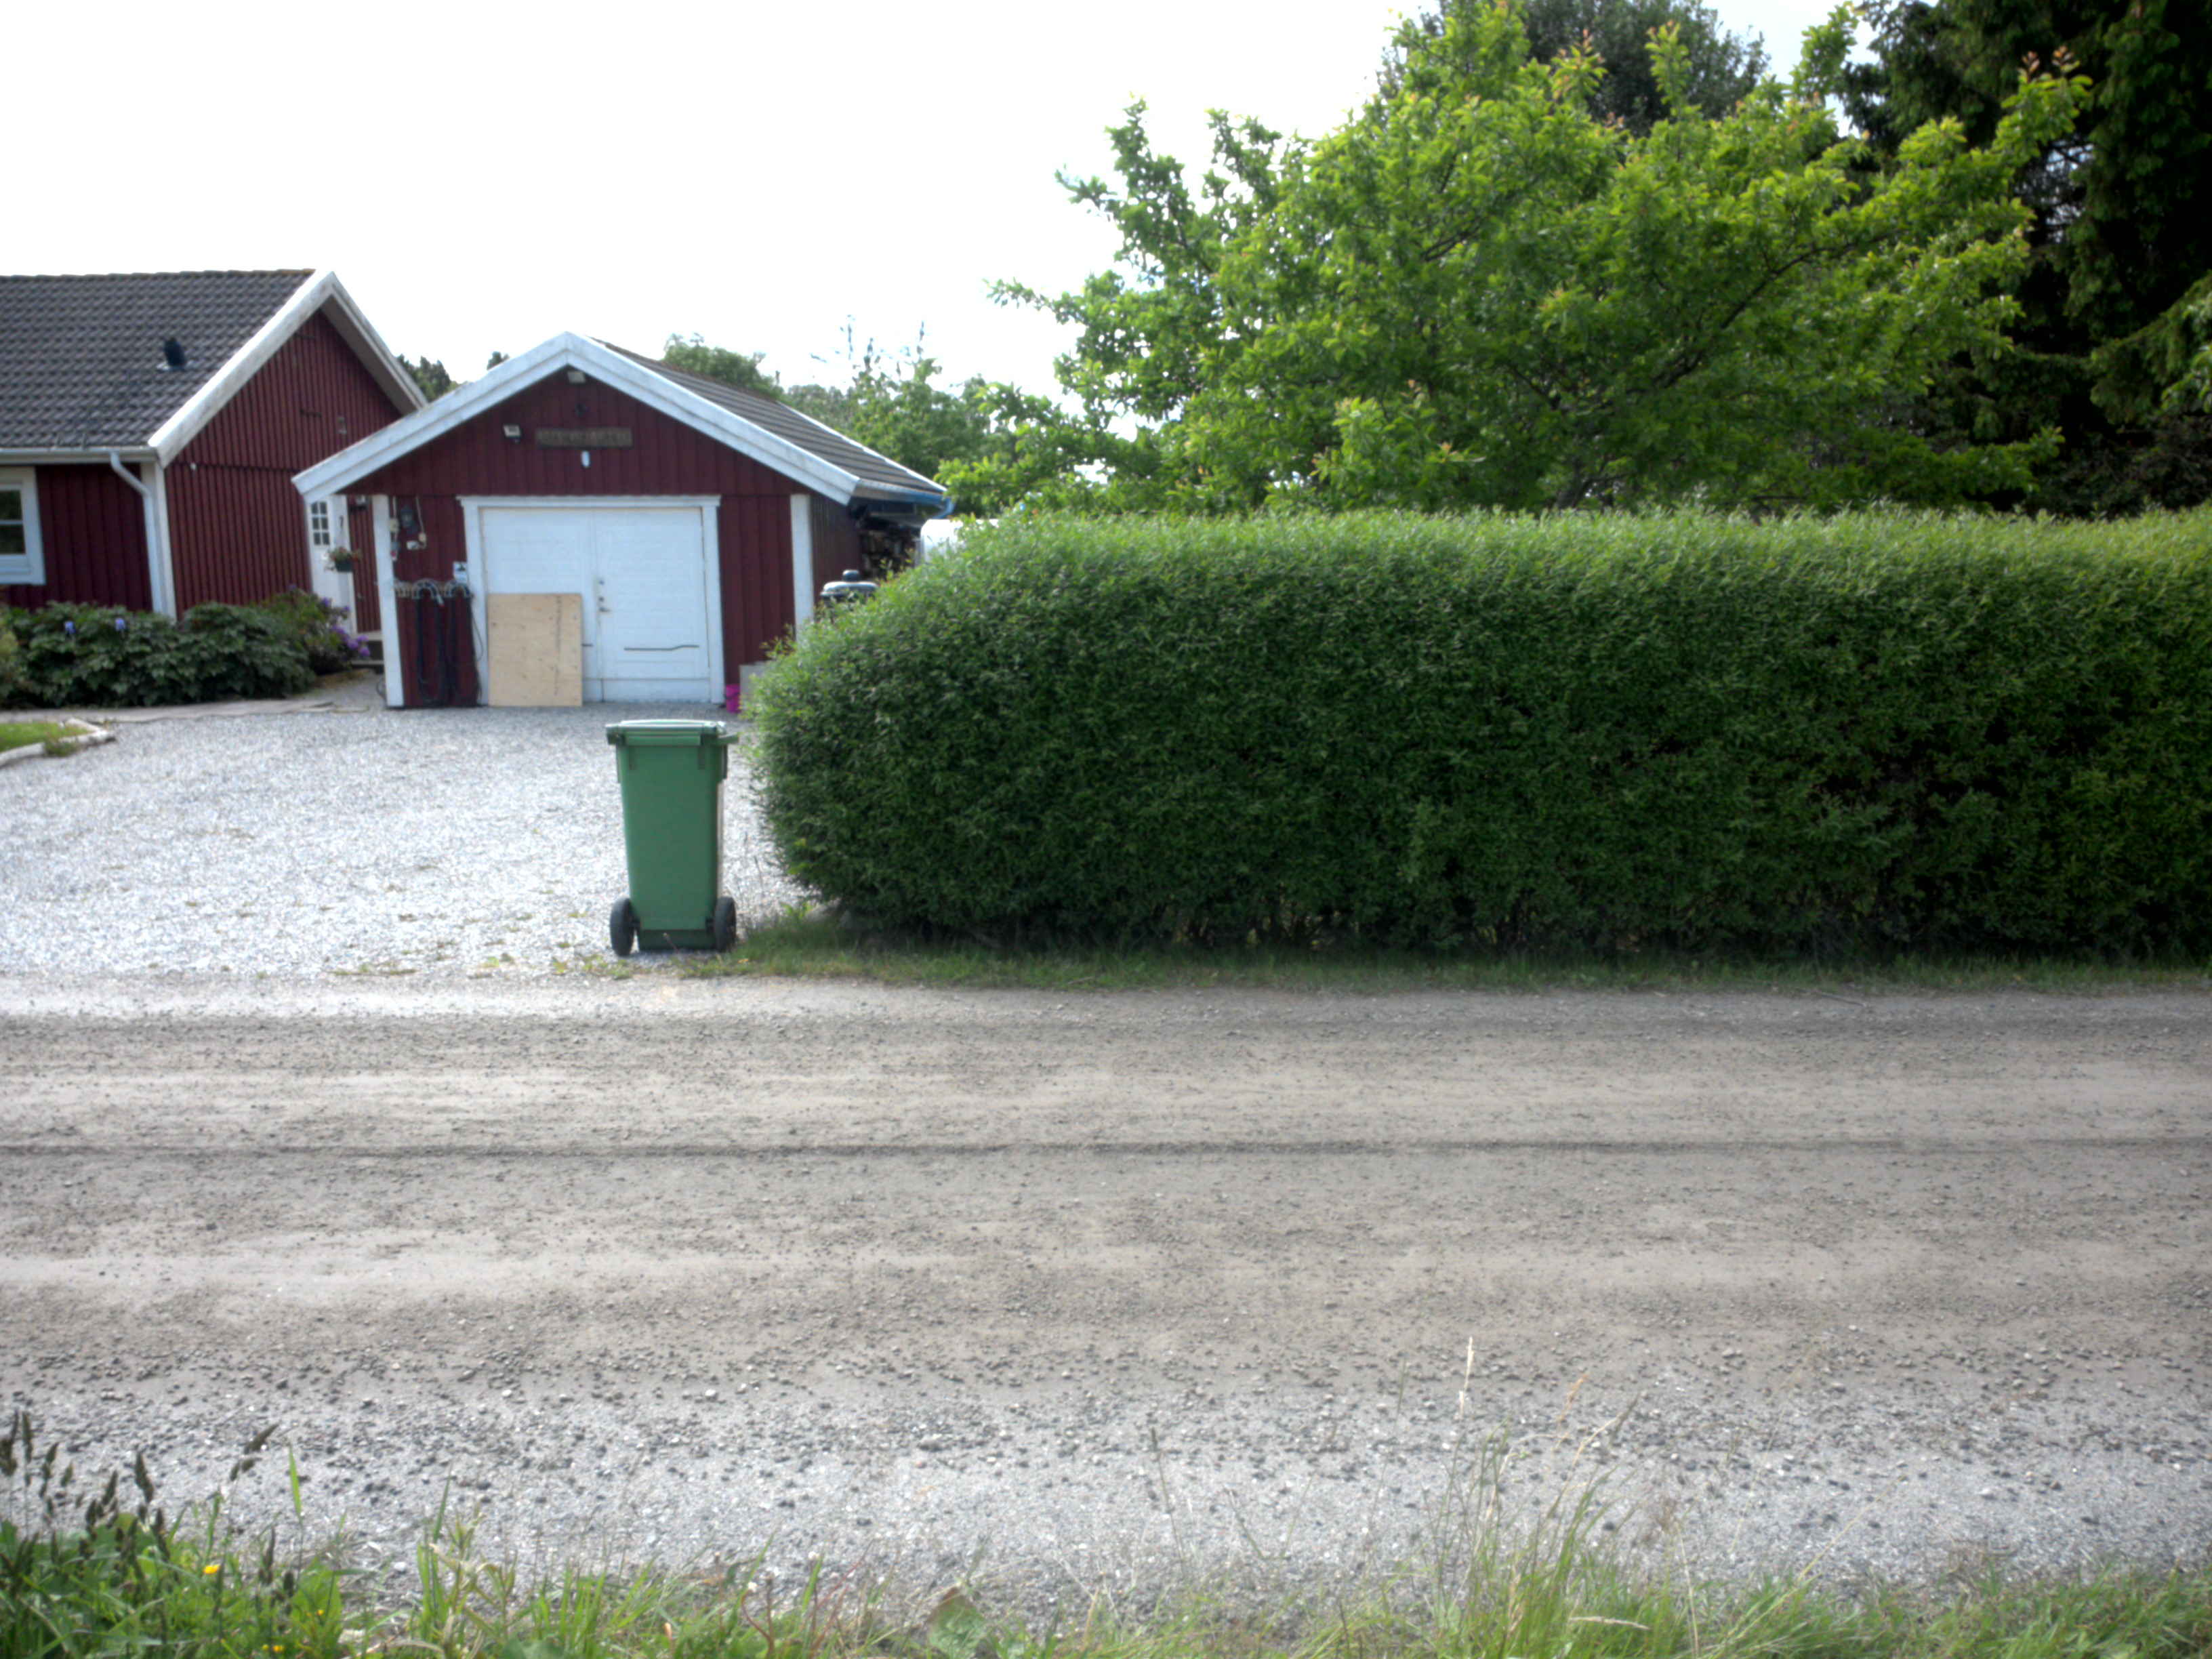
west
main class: Cropland
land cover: Oats
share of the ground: > 75 %
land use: Agriculture (excluding fallow land and kitchen gardens)
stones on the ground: < 10 %
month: June
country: SE
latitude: 59.4172
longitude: 17.5555
